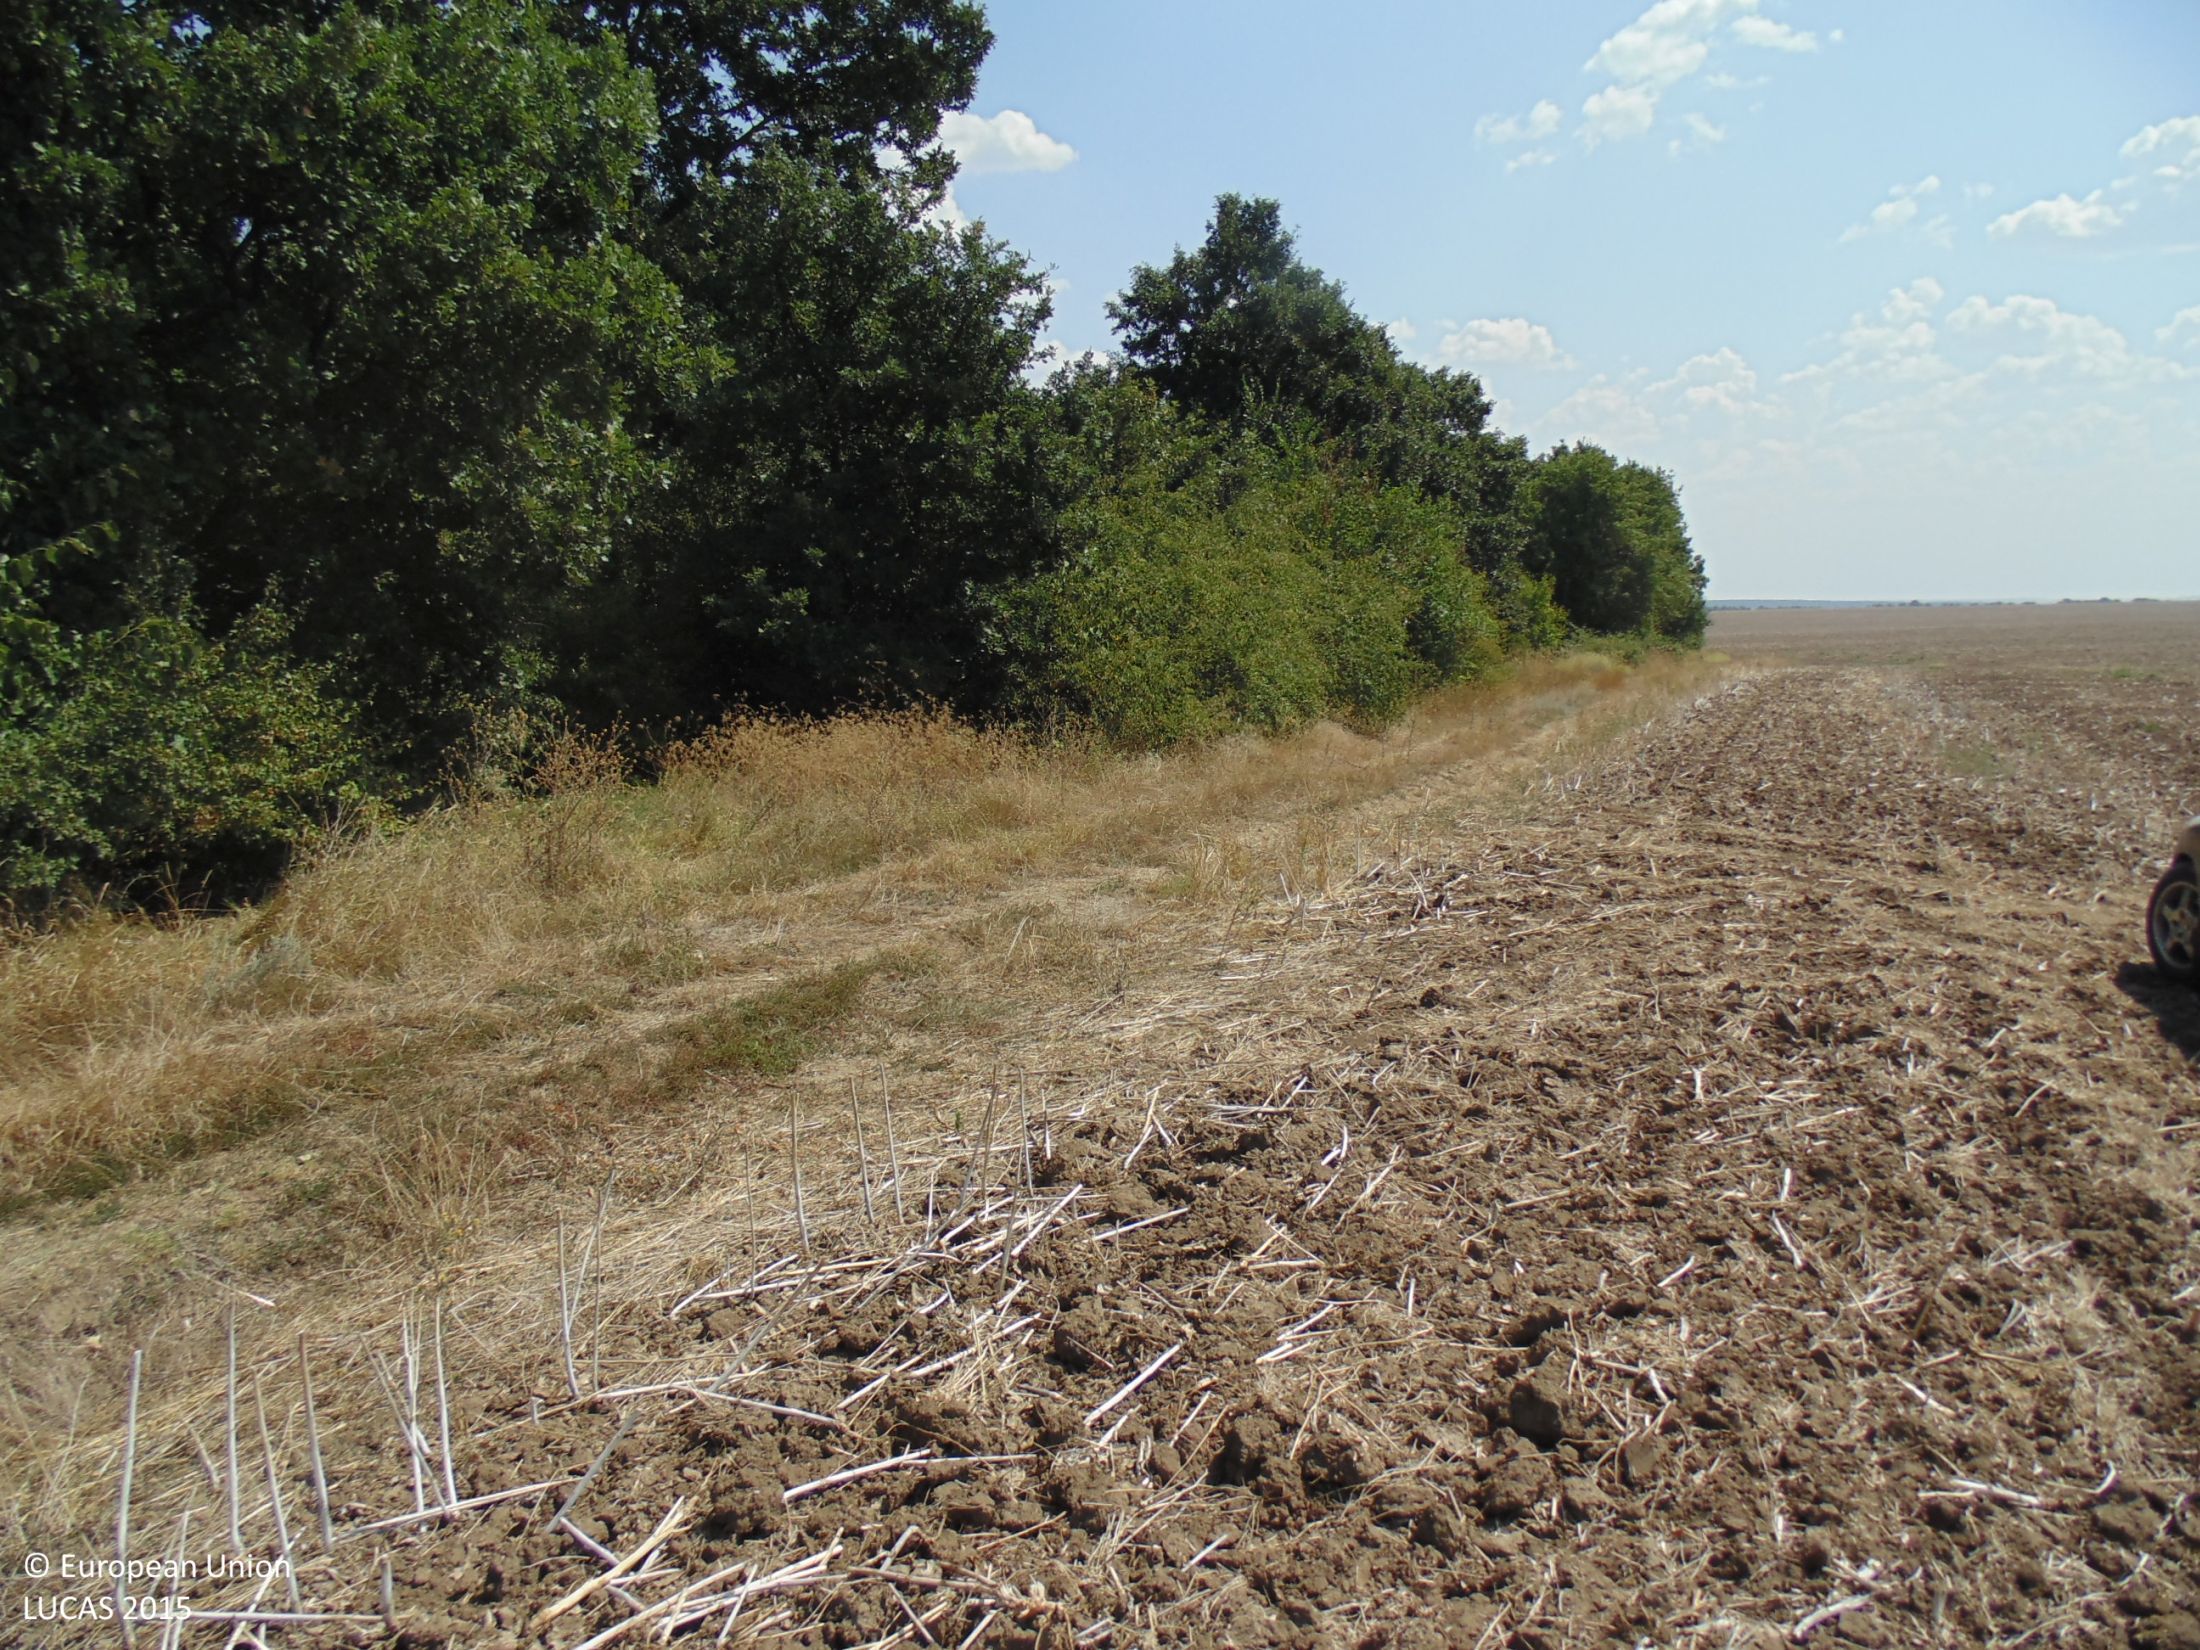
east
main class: Cropland
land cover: Rape and turnip rape
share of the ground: 10 - 25 %
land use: Agriculture (excluding fallow land and kitchen gardens)
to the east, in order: Rape and turnip rape; Grass margins; Tracks; Grass margins; Broadleaved woodland
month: August
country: BG
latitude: 43.9952
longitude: 27.5849
